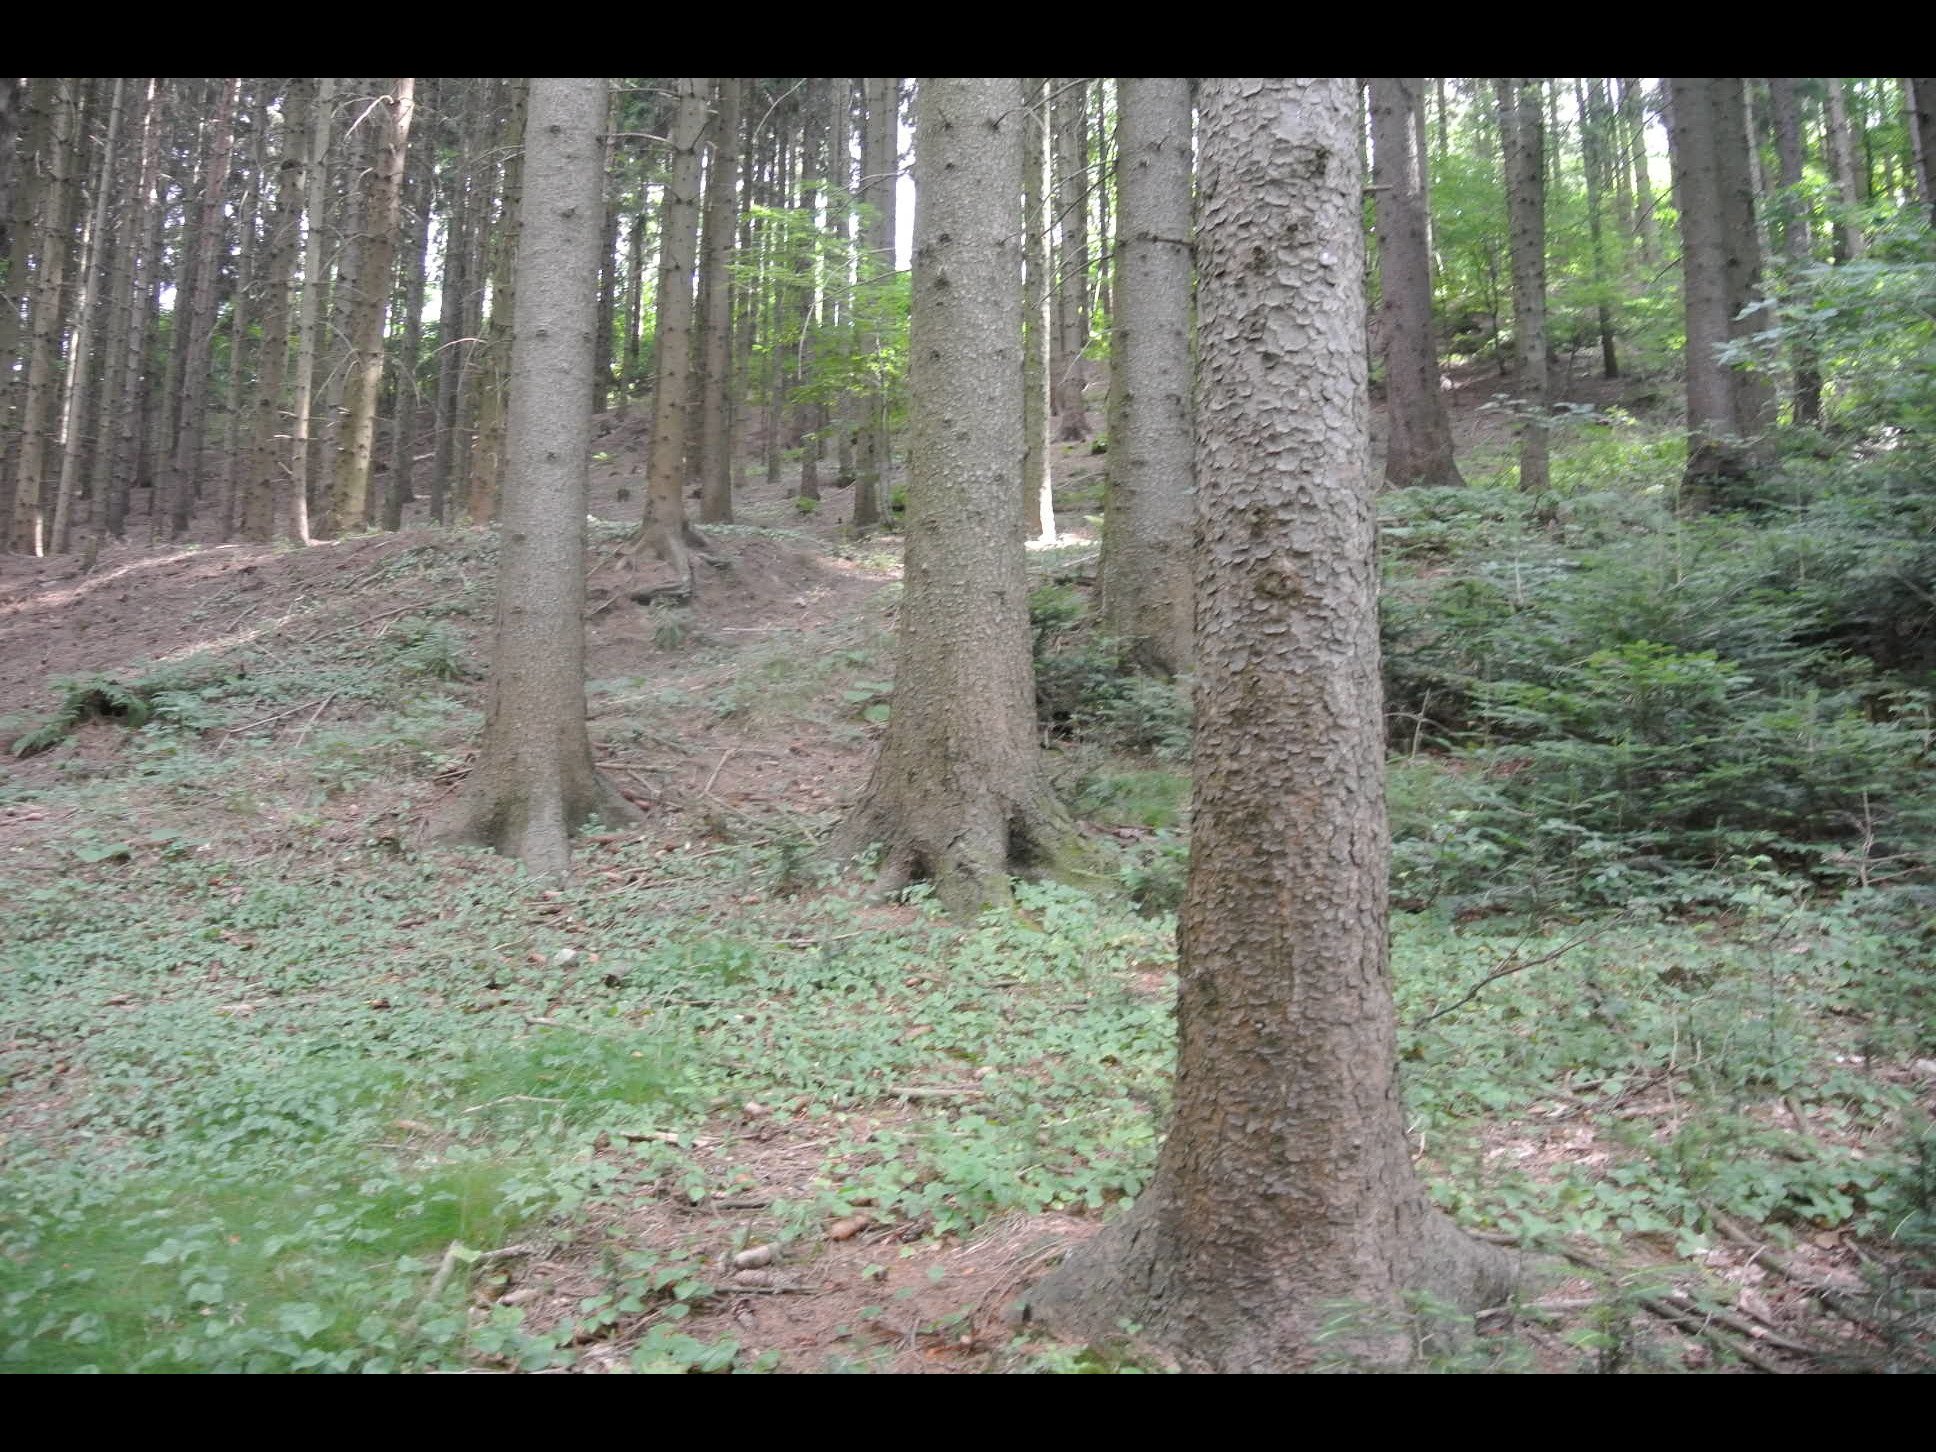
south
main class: Woodland
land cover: Spruce dominated coniferous woodland
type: alpine coniferous forest
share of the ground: > 75 %
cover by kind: coniferous forest trees 70 %, broadleaved forest trees 20 %, herbaceous plants 10 %
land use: Forestry
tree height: > 5 m
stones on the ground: < 10 %
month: July
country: AT
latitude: 47.5656
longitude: 16.1302
